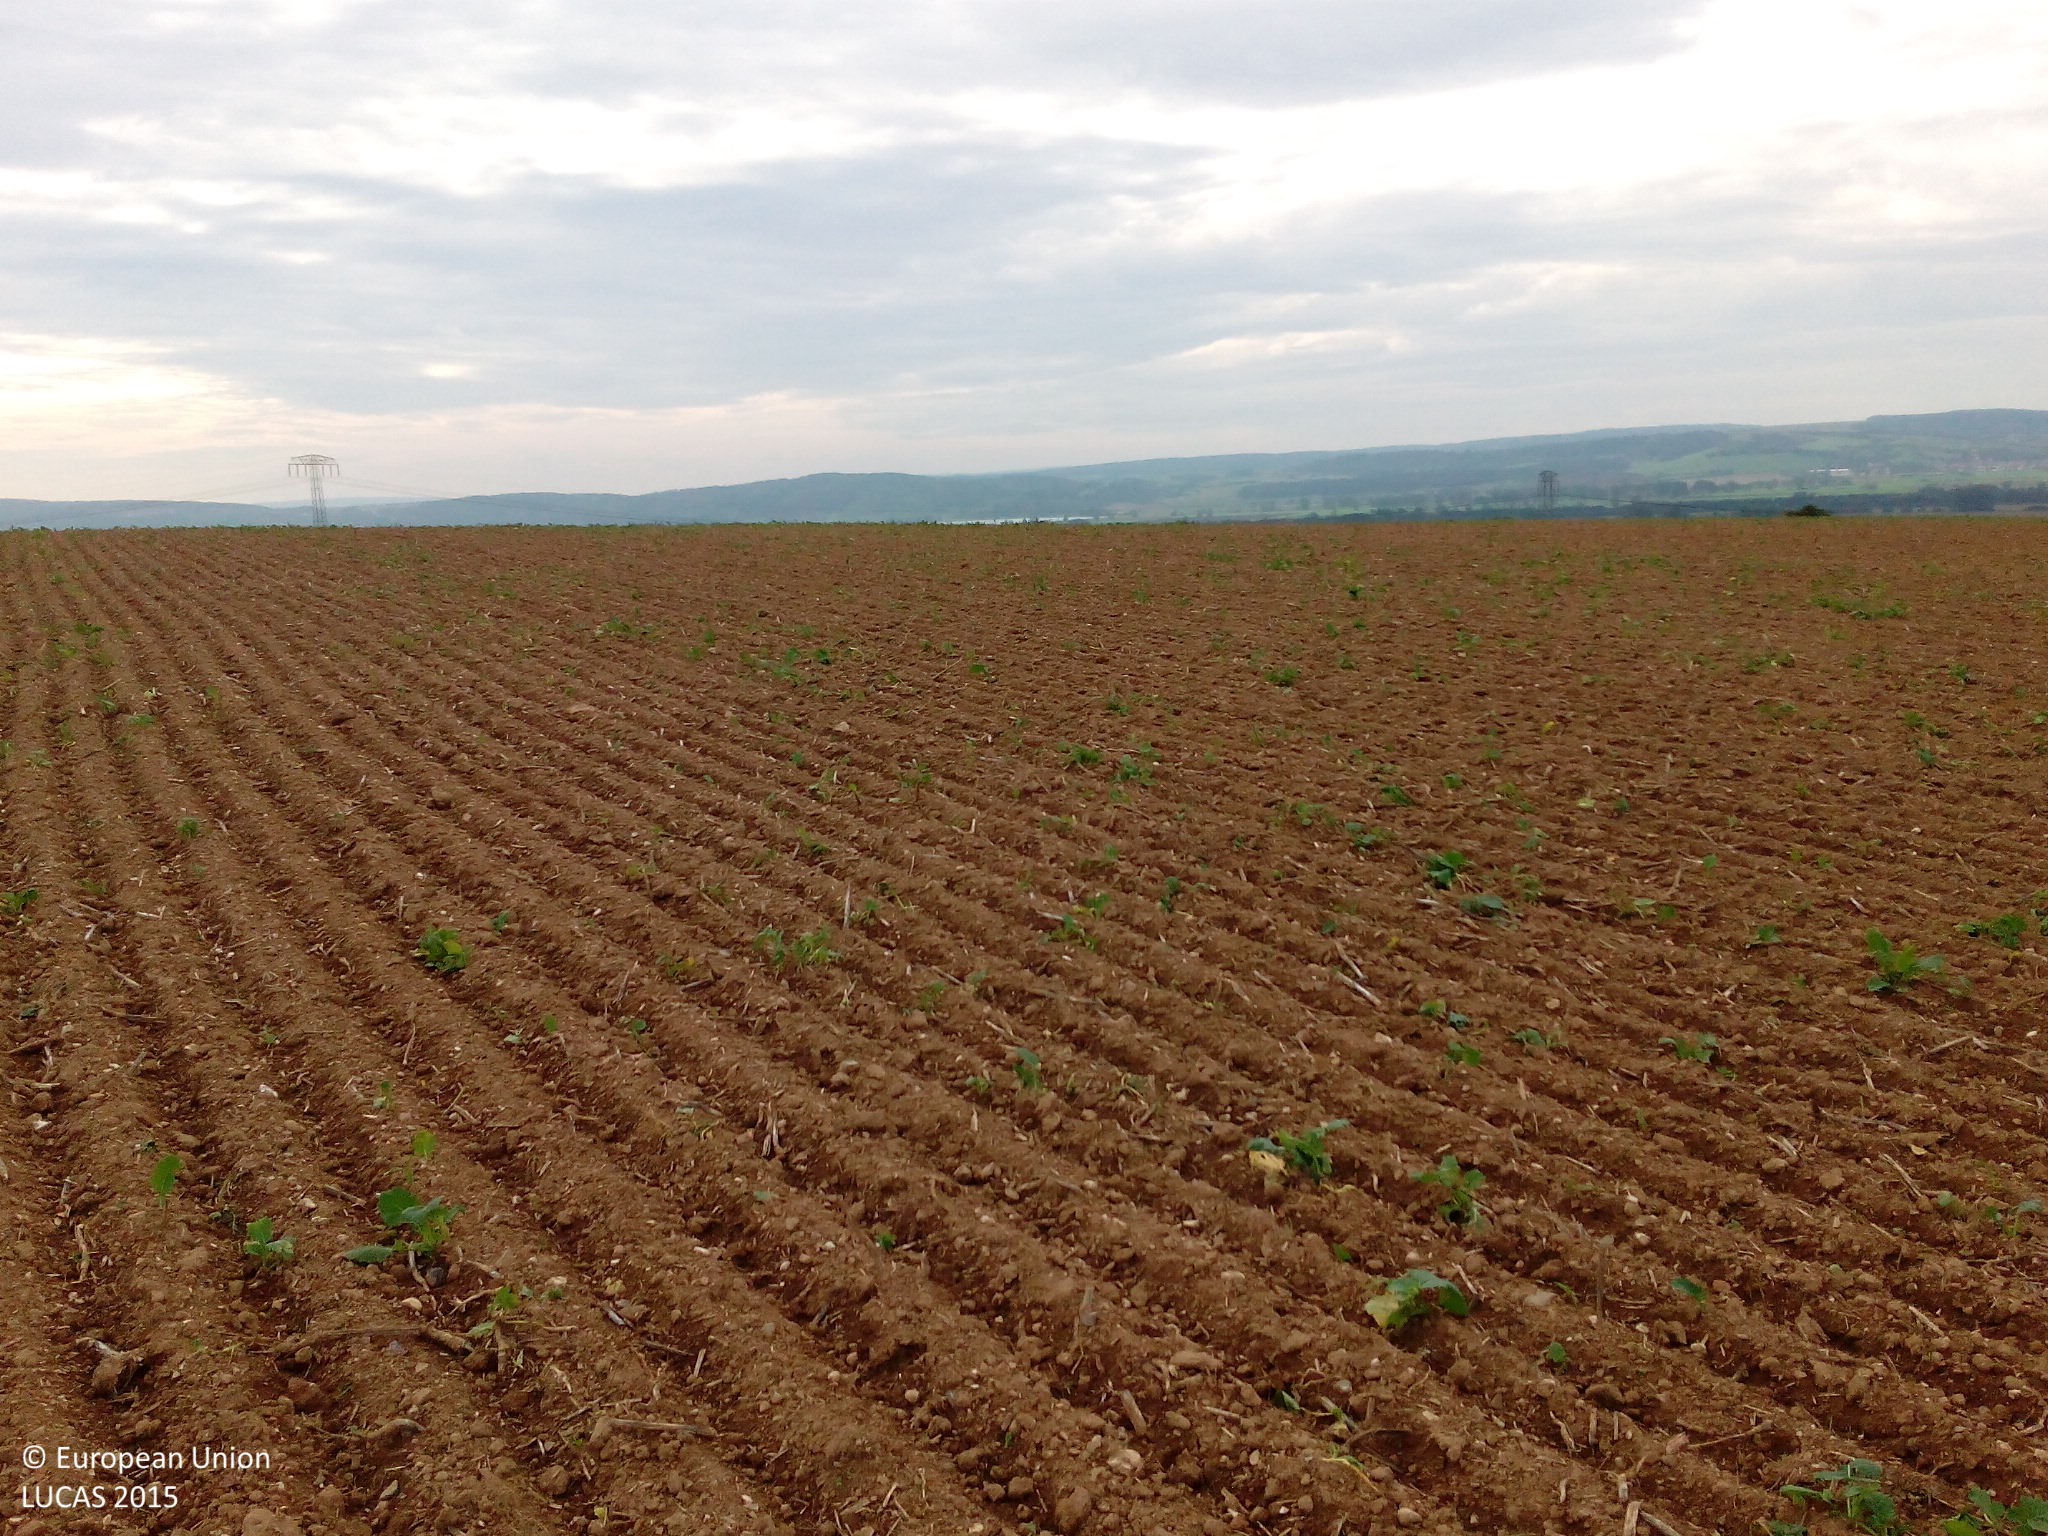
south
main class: Cropland
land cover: Rape and turnip rape
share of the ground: < 10 %
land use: Agriculture (excluding fallow land and kitchen gardens)
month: September
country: DE
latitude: 51.4747
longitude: 10.9643
